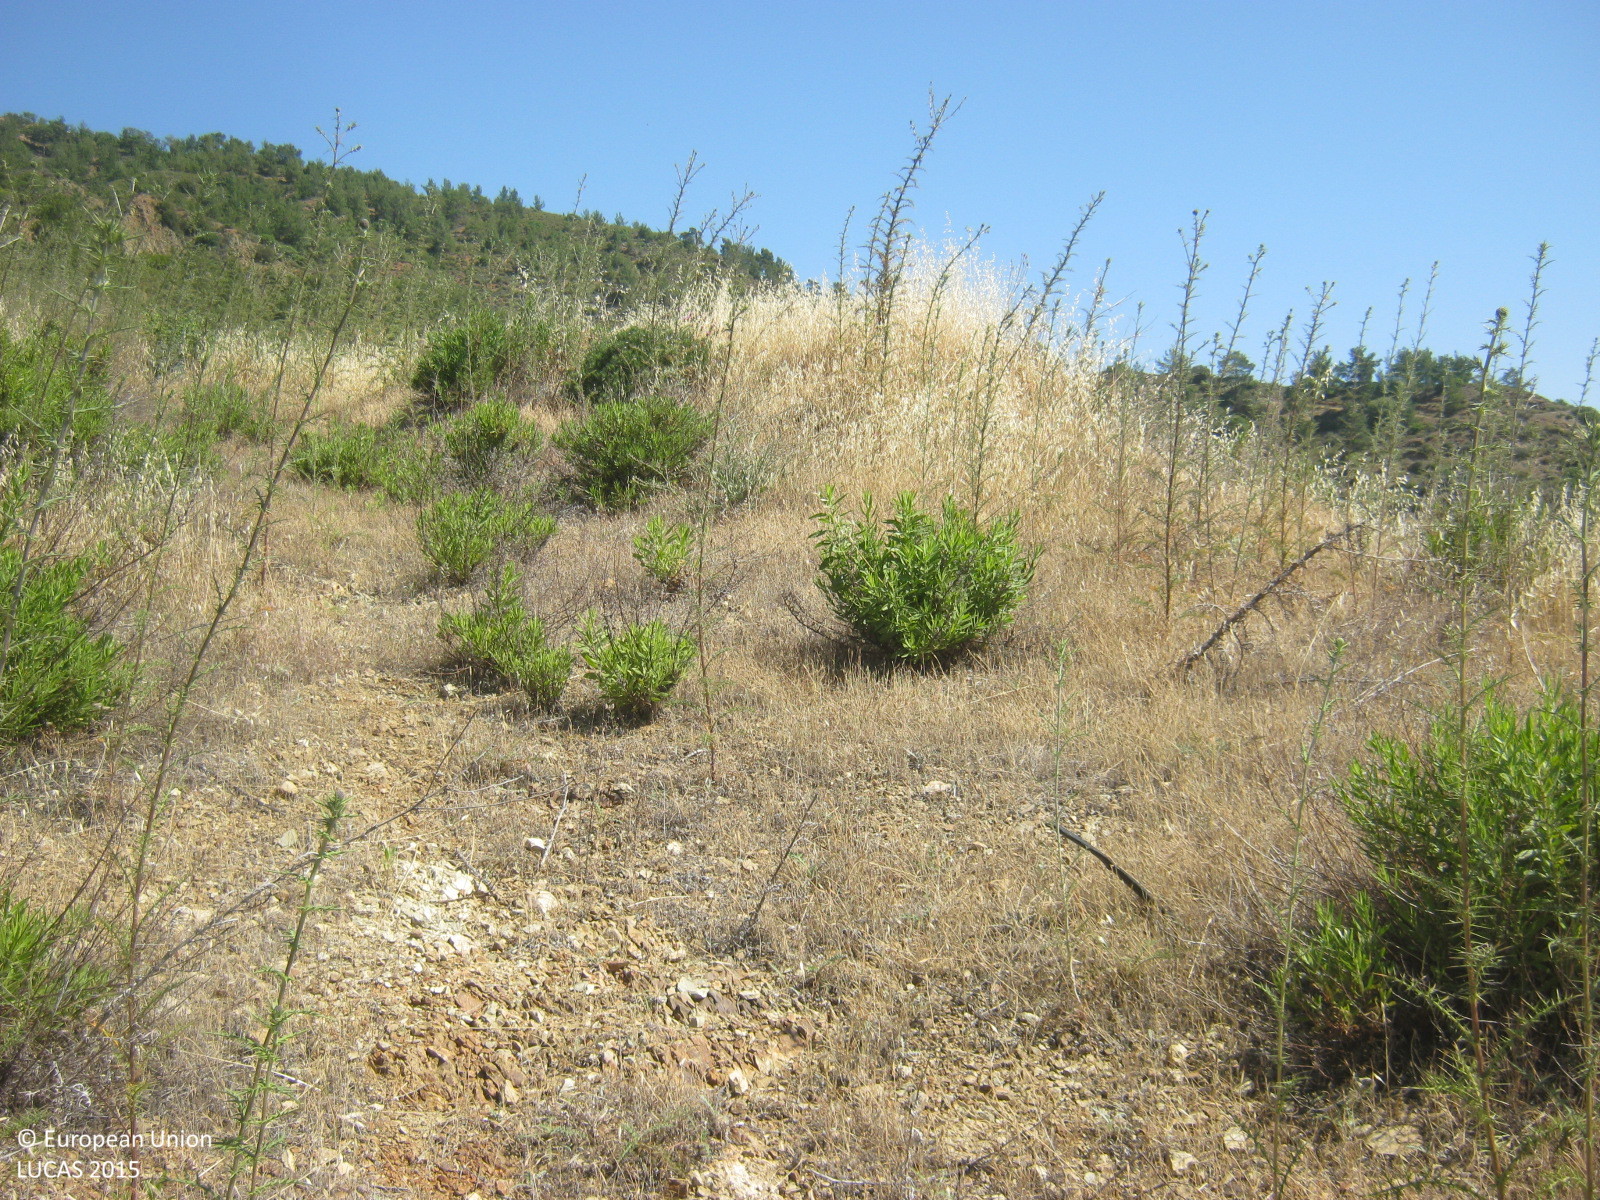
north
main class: Shrubland
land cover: Shrubland without tree cover
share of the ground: 25 - 50 %
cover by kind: herbaceous plants 60 %, shrubs 30 %, unconsolidated bare surface 10 %
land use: Semi-natural and natural areas not in use
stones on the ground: 25 - 50 %
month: June
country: CY
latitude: 35.0092
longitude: 32.8173
